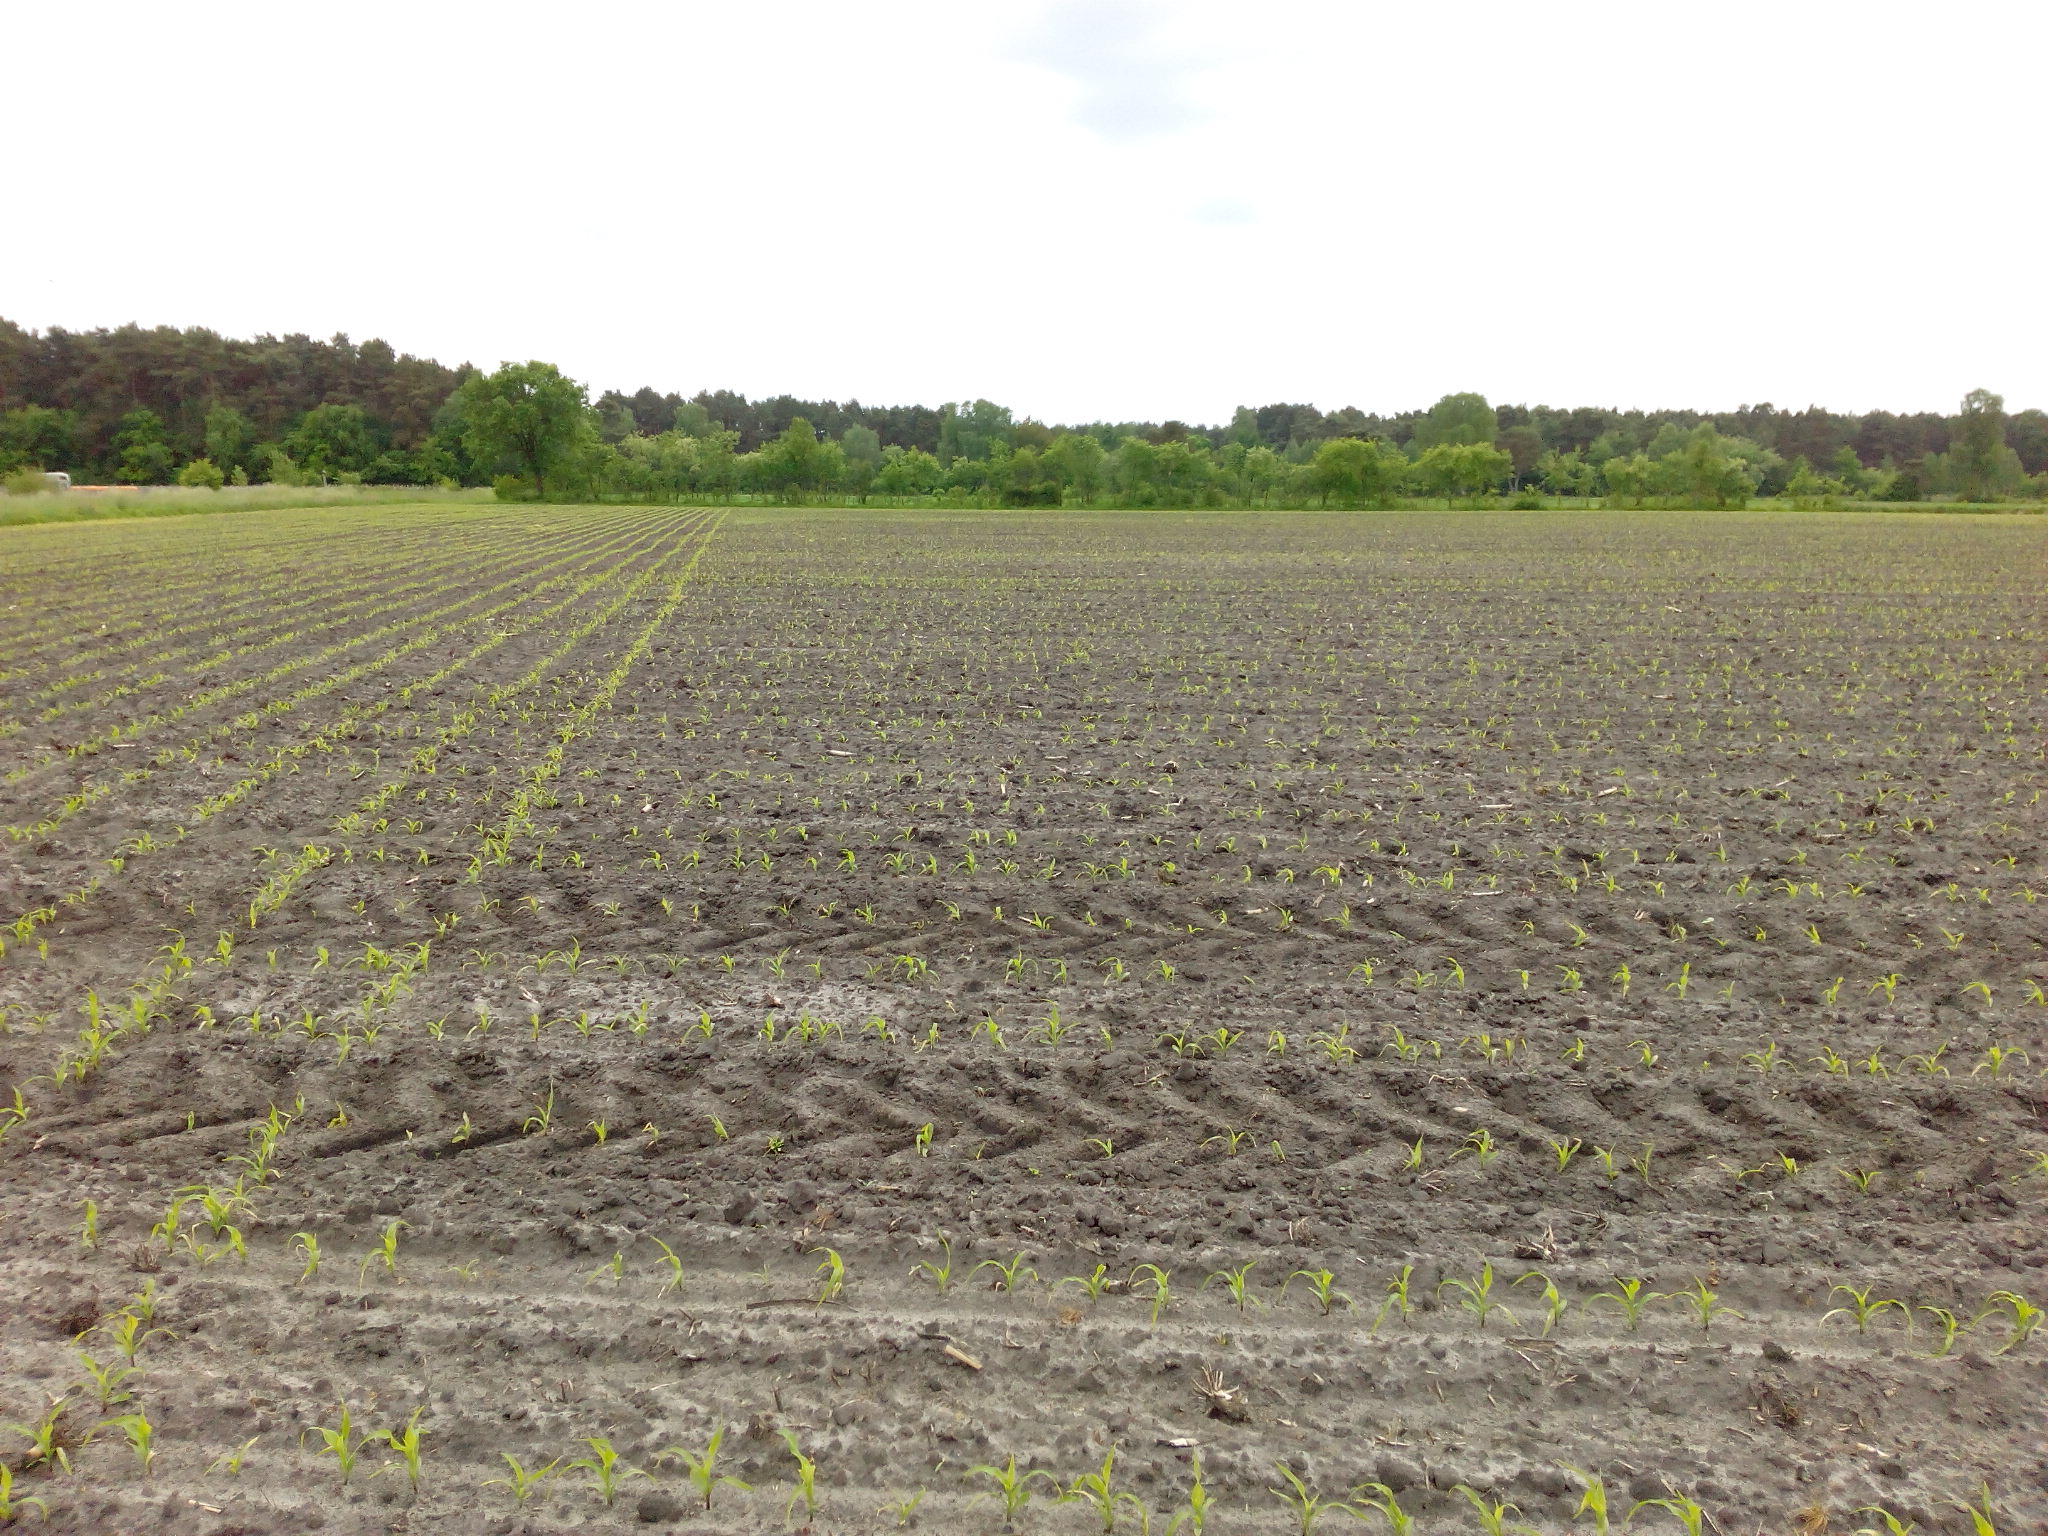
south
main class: Cropland
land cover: Maize
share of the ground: < 10 %
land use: Agriculture (excluding fallow land and kitchen gardens)
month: June
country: DE
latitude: 52.6470
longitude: 9.9261
